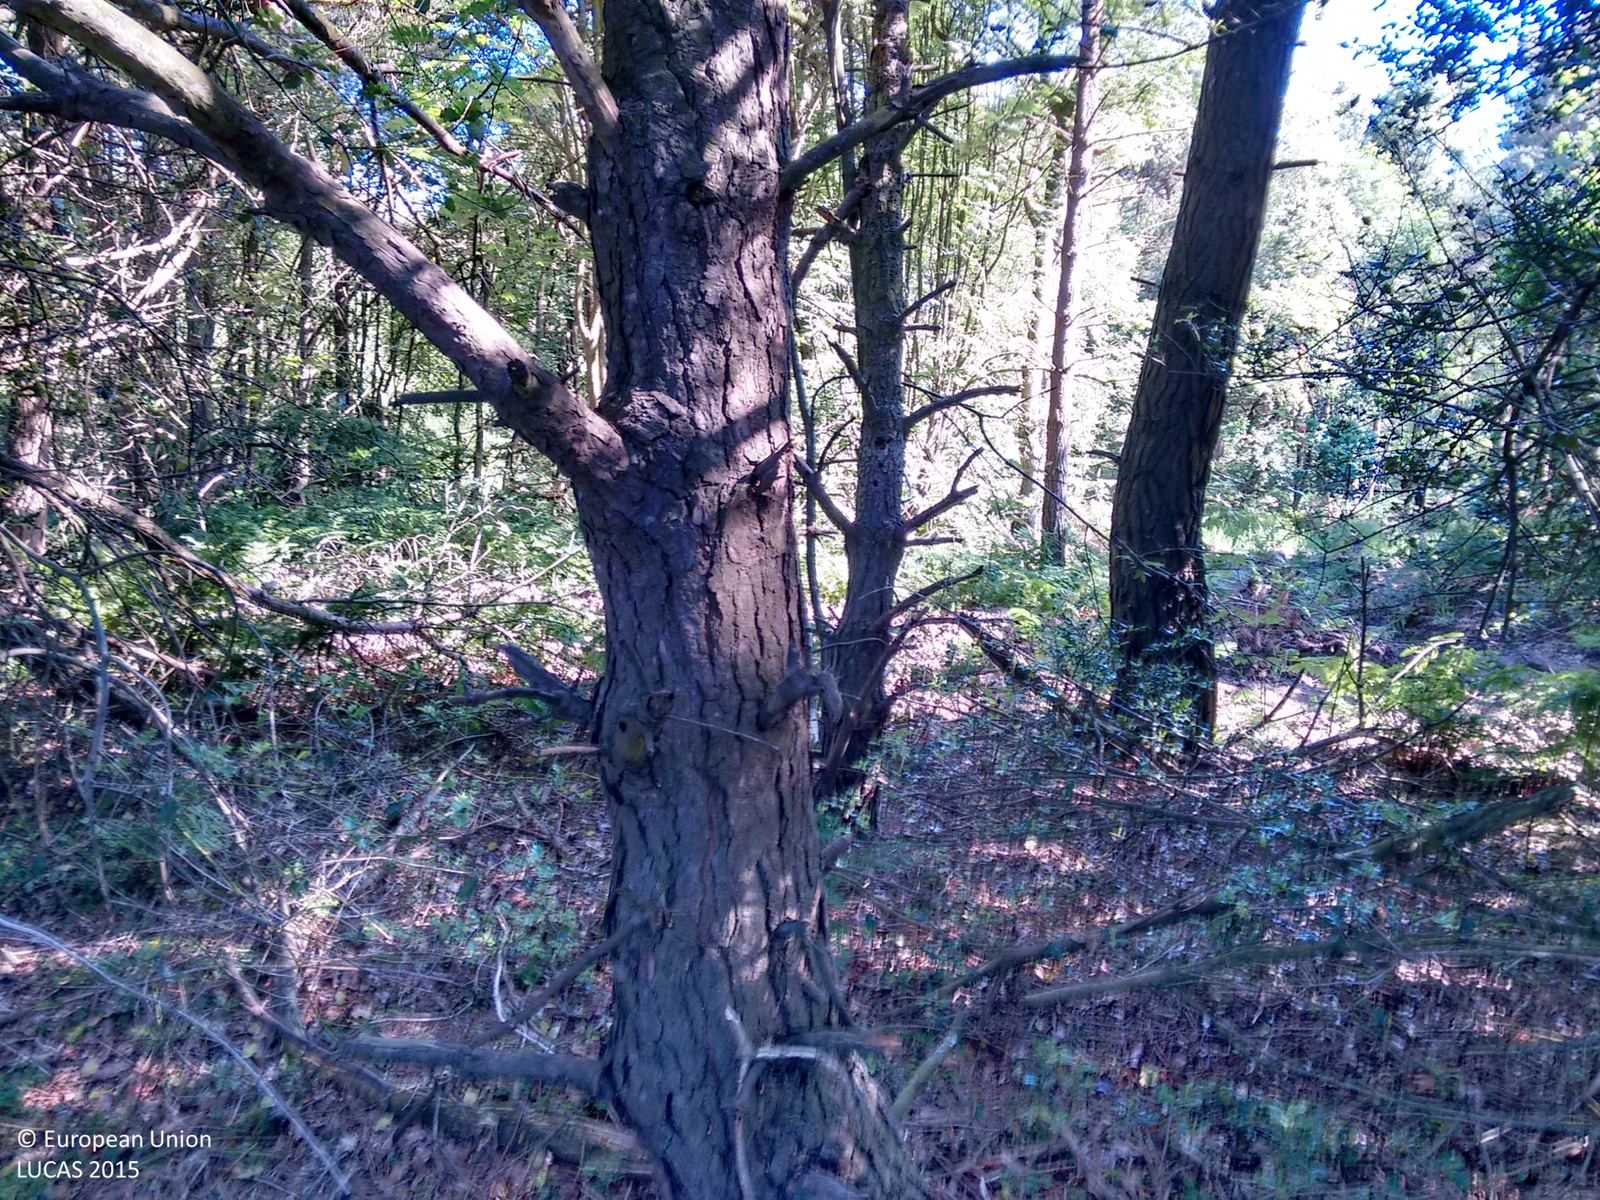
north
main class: Woodland
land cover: Other mixed woodland
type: hemiboreal forest and nemoral coniferous forest and mixed broadleaved-coniferous forest
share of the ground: > 75 %
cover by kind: broadleaved forest trees 60 %, coniferous forest trees 40 %
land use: Forestry
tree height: > 5 m
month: July
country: GB
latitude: 54.3601
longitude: -0.4848
